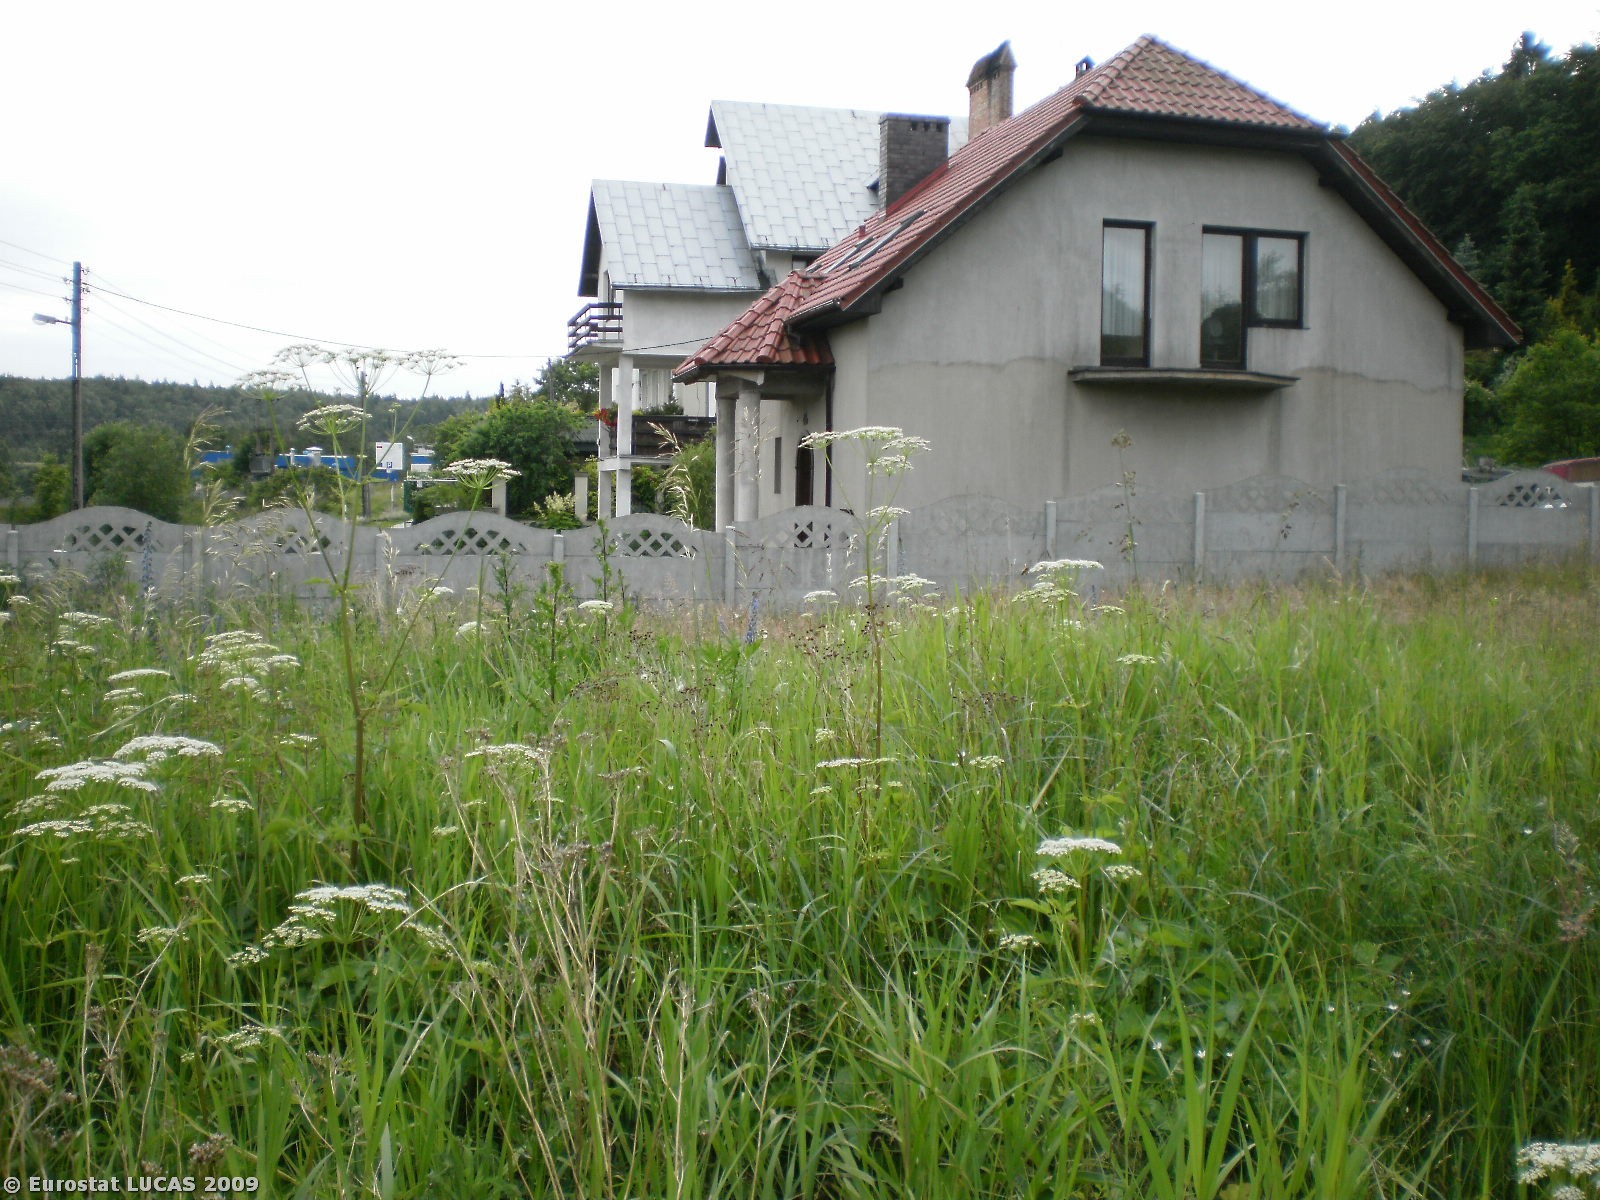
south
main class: Grassland
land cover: Grassland with sparse tree/shrub cover
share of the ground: > 75 %
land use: Unused
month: June
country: PL
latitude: 54.4597
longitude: 18.4858
